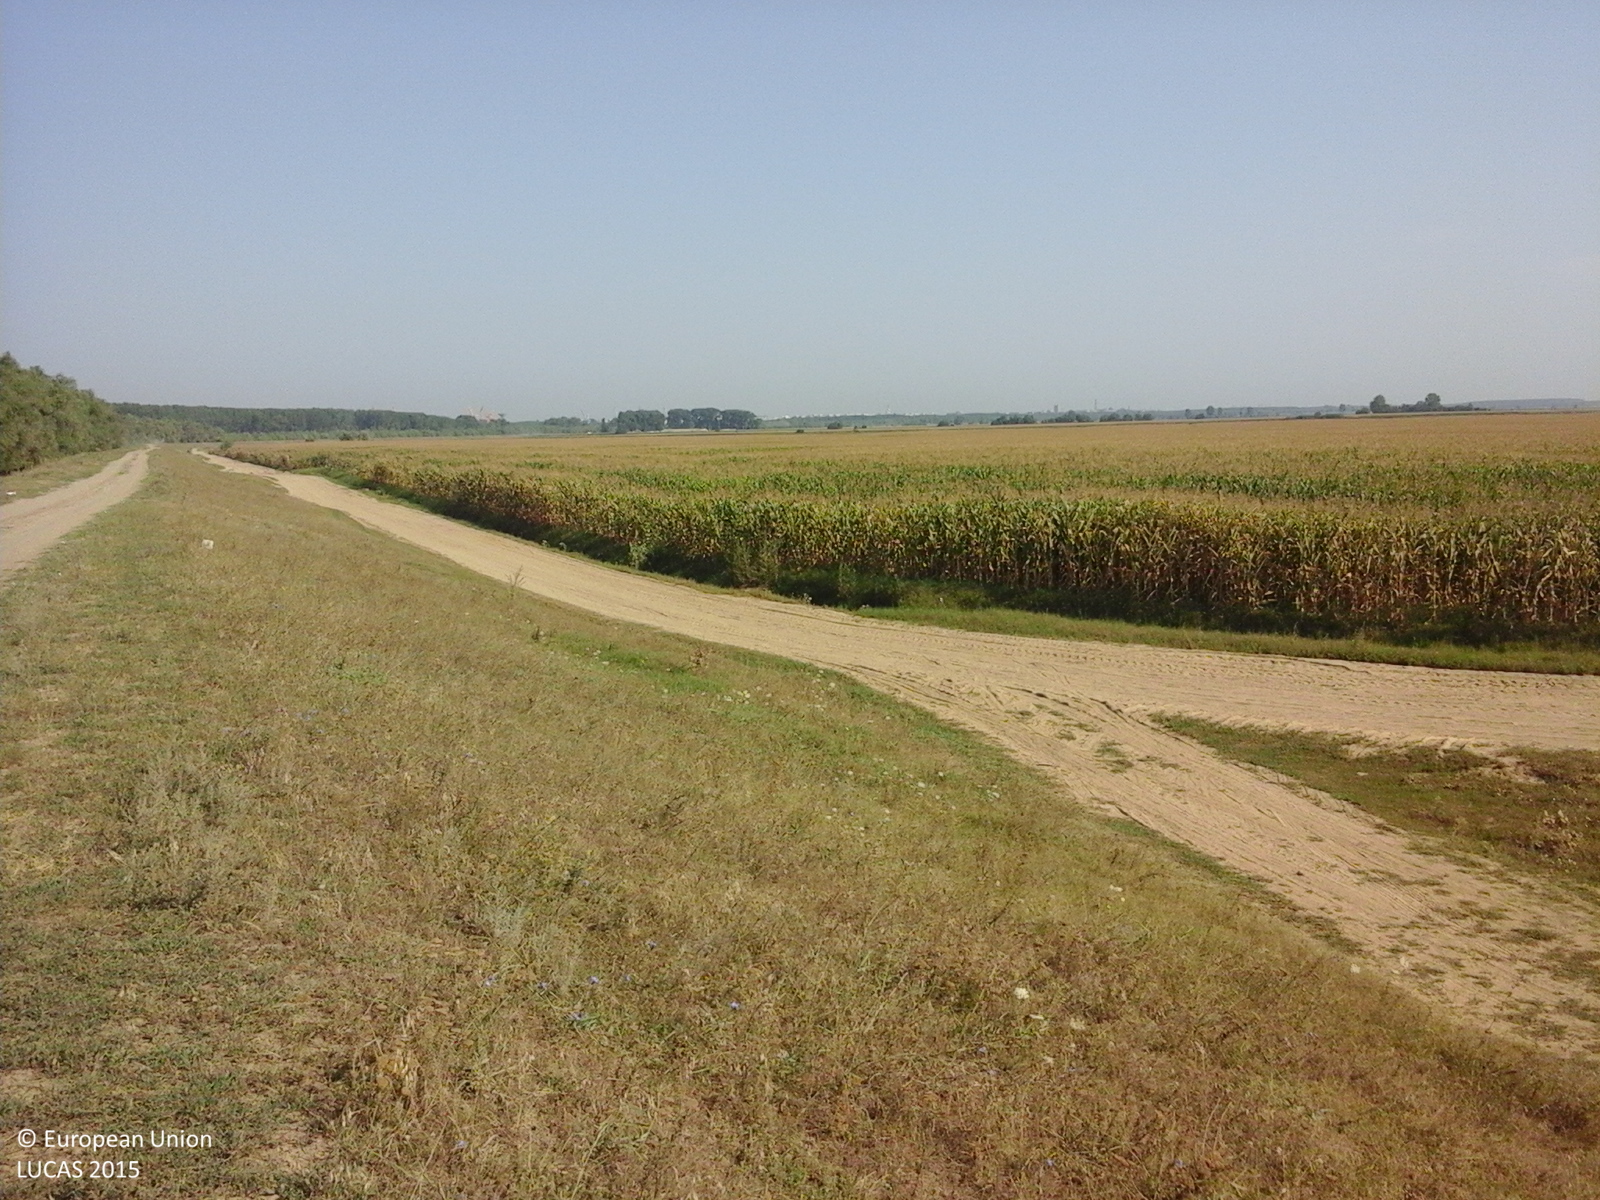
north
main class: Grassland
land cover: Spontaneously vegetated surfaces
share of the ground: > 75 %
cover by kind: herbaceous plants 100 %
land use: Agriculture (excluding fallow land and kitchen gardens)
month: August
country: RO
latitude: 45.2169
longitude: 27.9801
